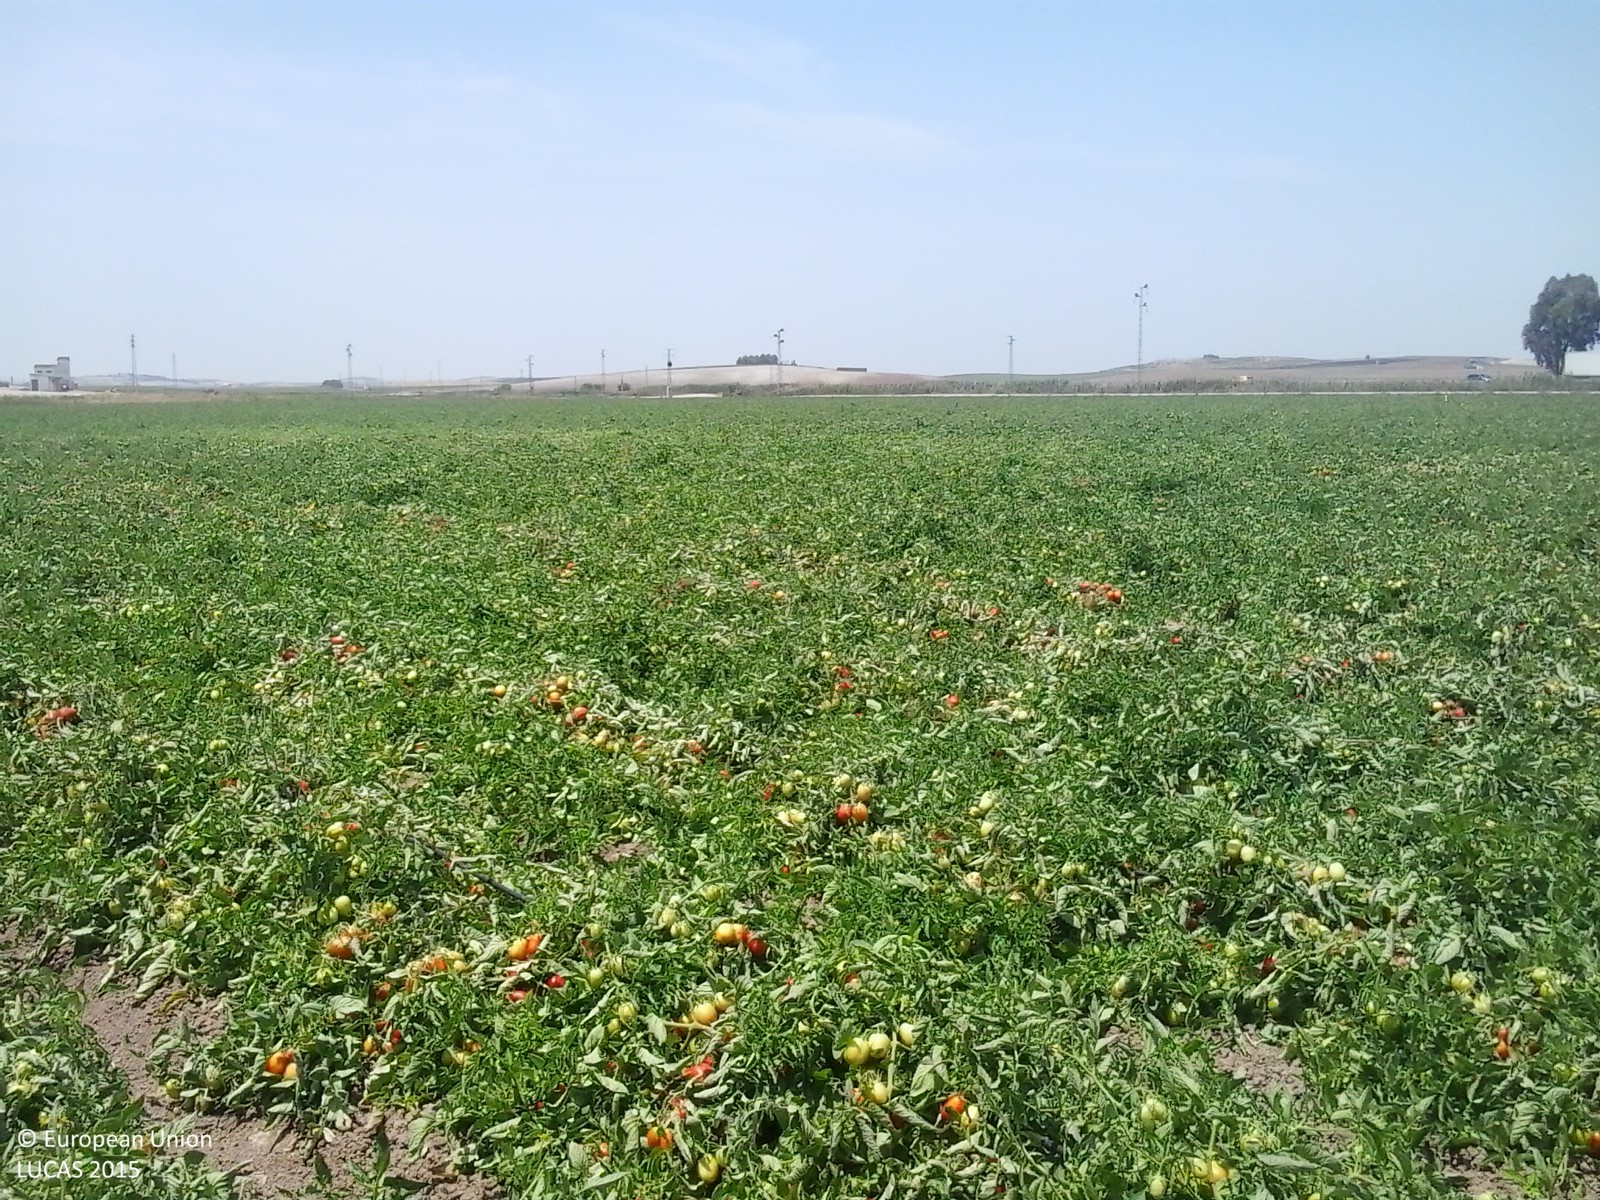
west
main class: Cropland
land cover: Tomatoes
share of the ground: > 75 %
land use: Agriculture (excluding fallow land and kitchen gardens)
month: July
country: ES
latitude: 36.9556
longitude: -5.9964
